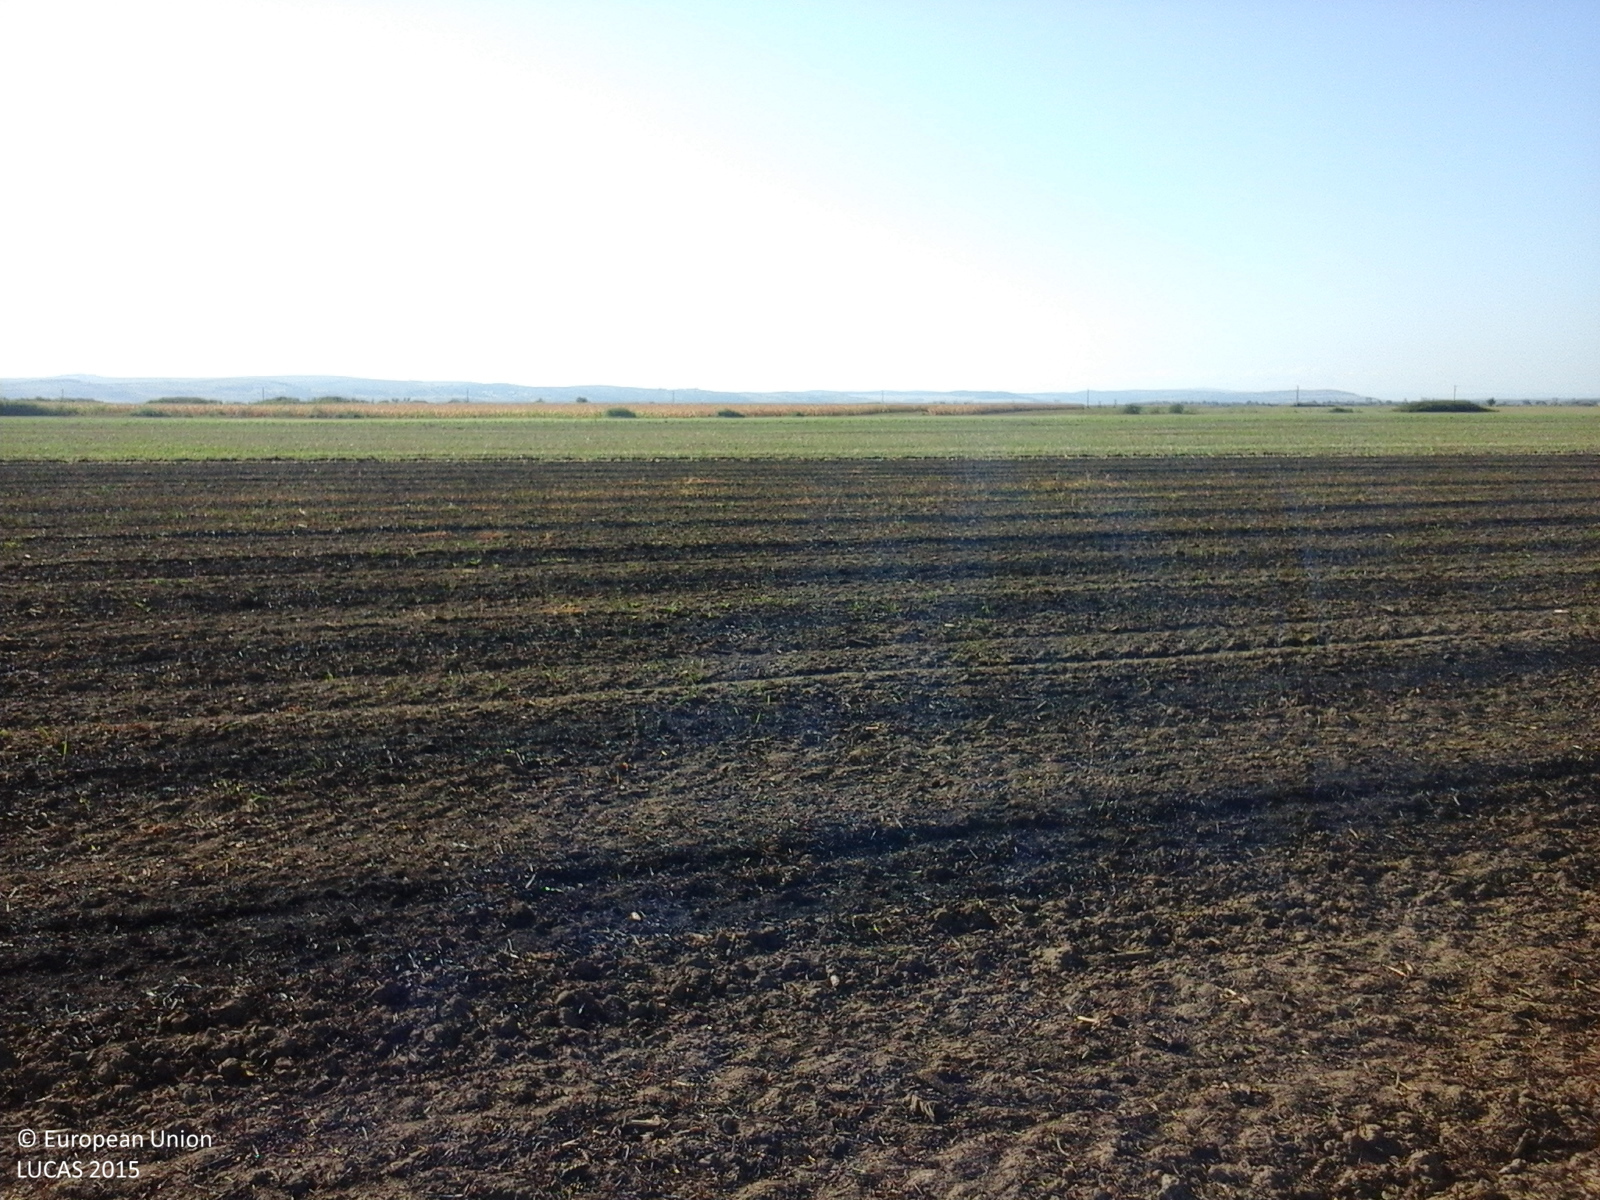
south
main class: Cropland
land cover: Common wheat
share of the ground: < 10 %
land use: Agriculture (excluding fallow land and kitchen gardens)
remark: Burnt area
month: September
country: RO
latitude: 47.5461
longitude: 22.8041
